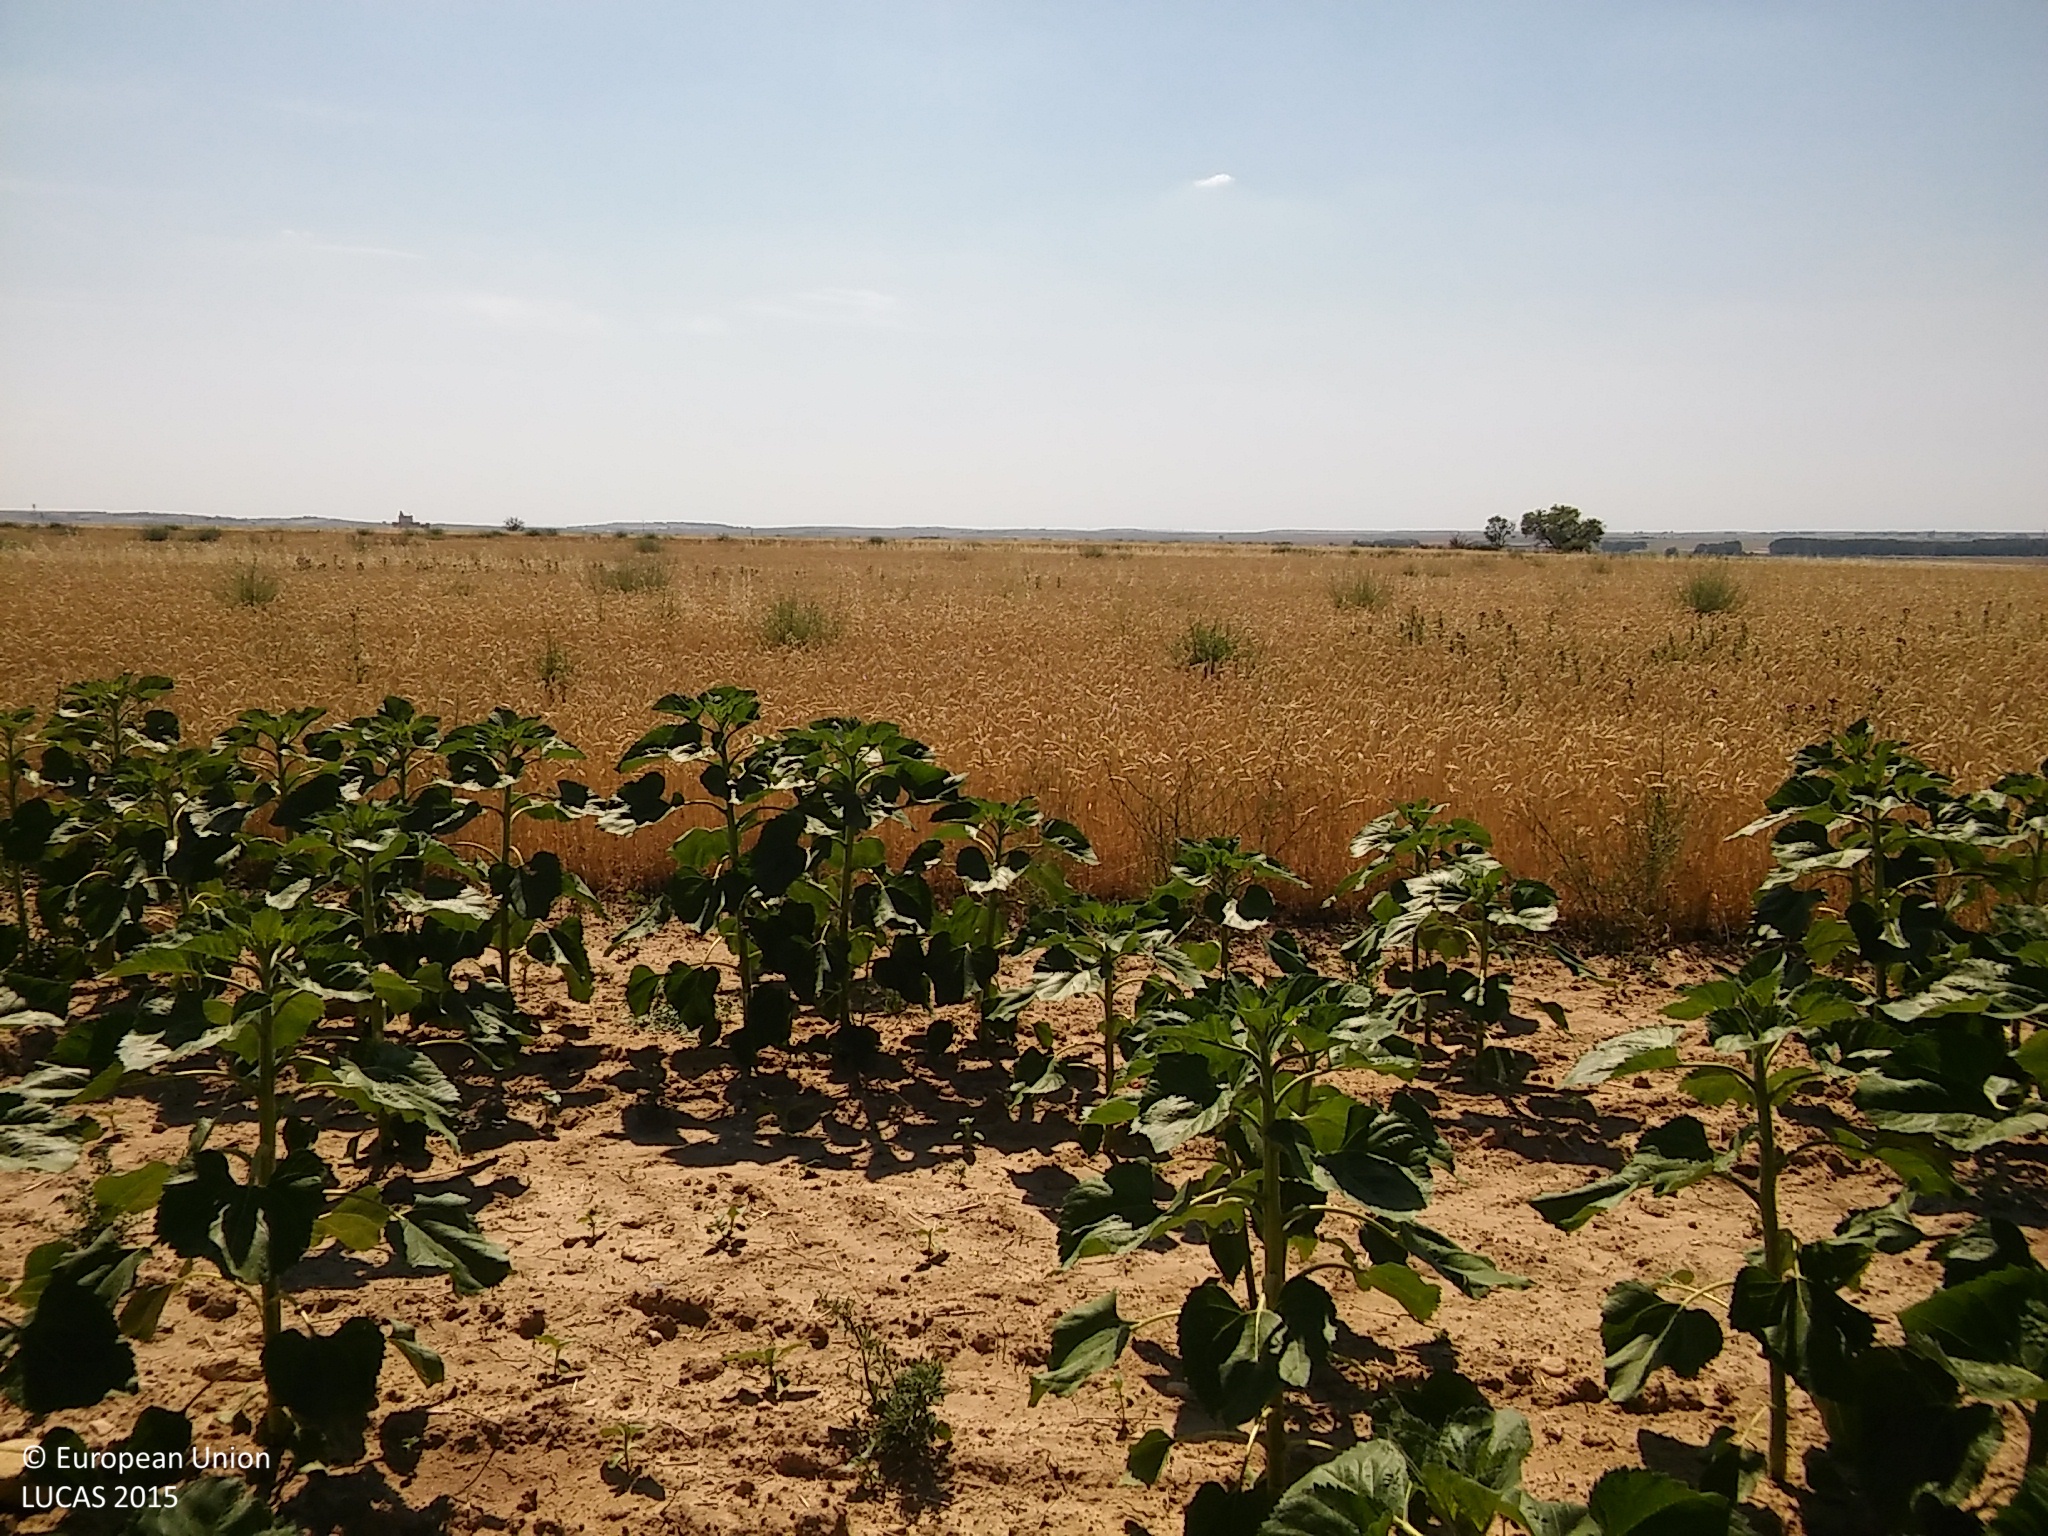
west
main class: Cropland
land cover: Sunflower
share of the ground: 25 - 50 %
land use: Agriculture (excluding fallow land and kitchen gardens)
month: June
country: ES
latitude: 41.1660
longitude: -3.9837
